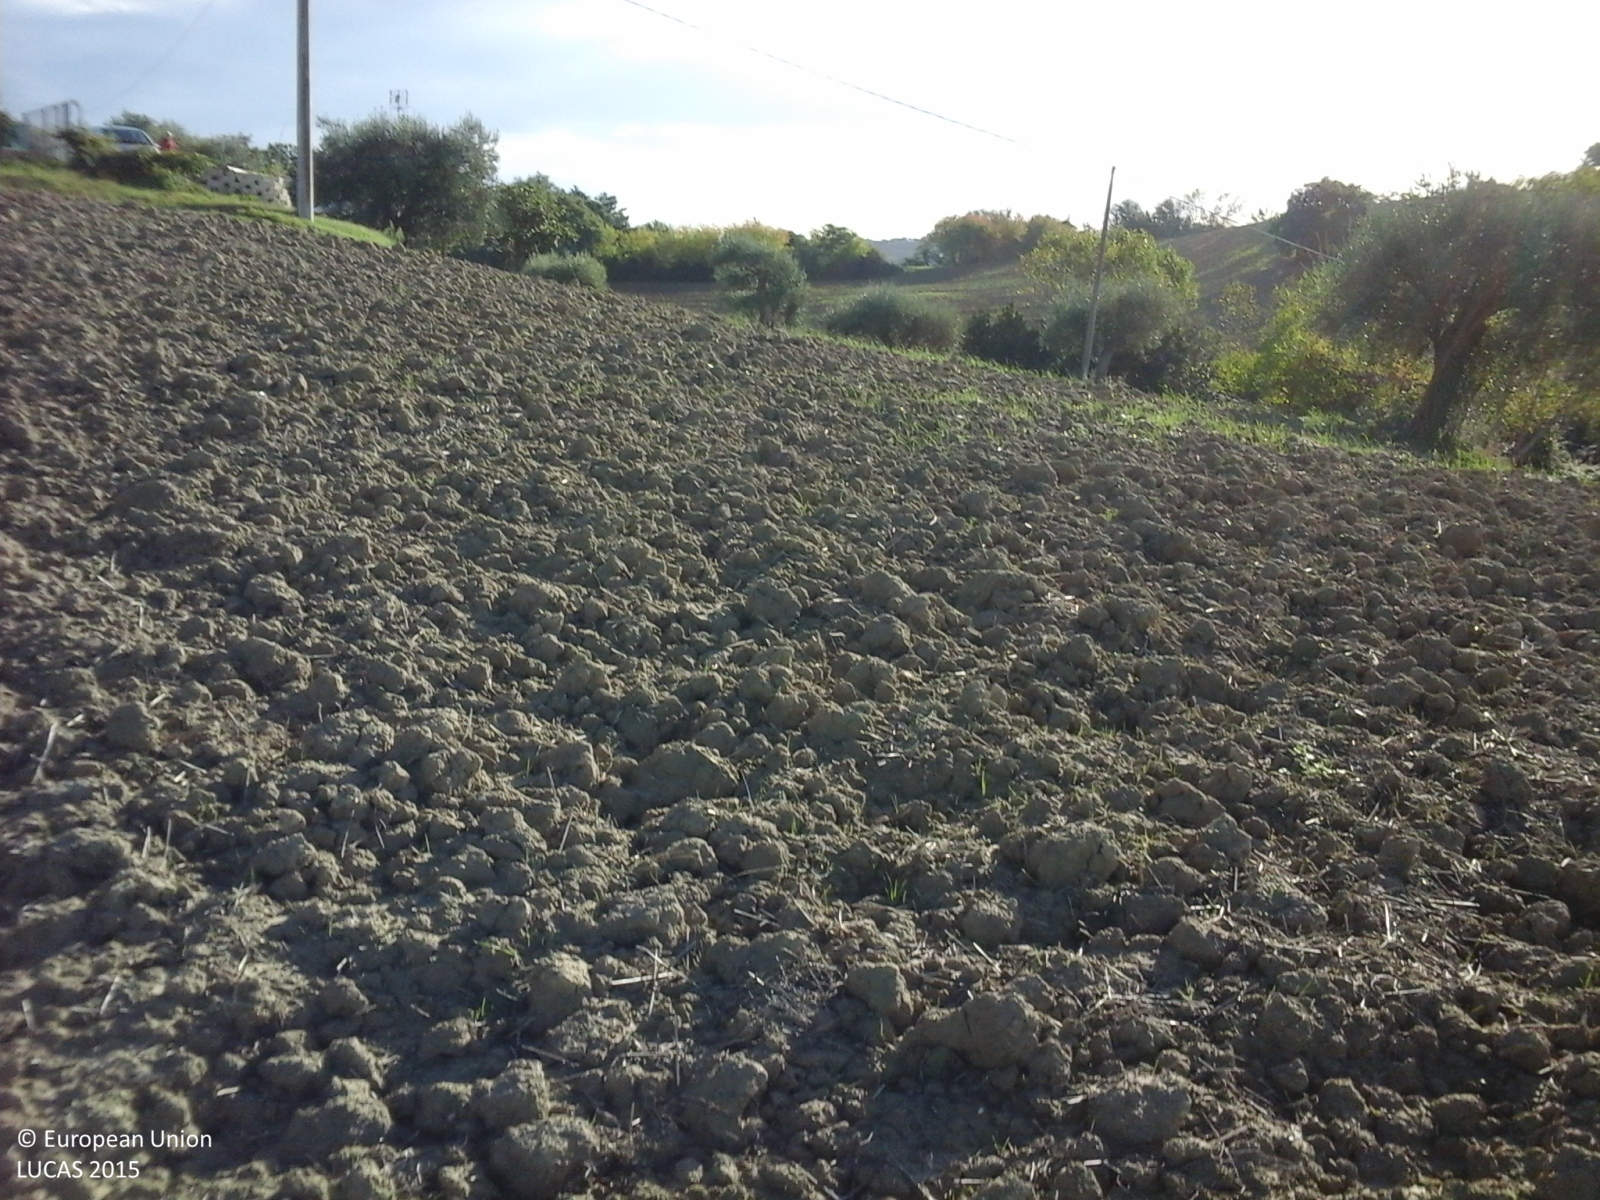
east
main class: Cropland
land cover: Durum wheat
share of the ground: < 10 %
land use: Agriculture (excluding fallow land and kitchen gardens)
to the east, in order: Durum wheat; Olive groves; Electric lines; Olive groves; Durum wheat; Broadleaved woodland
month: October
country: IT
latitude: 43.6520
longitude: 13.1788
